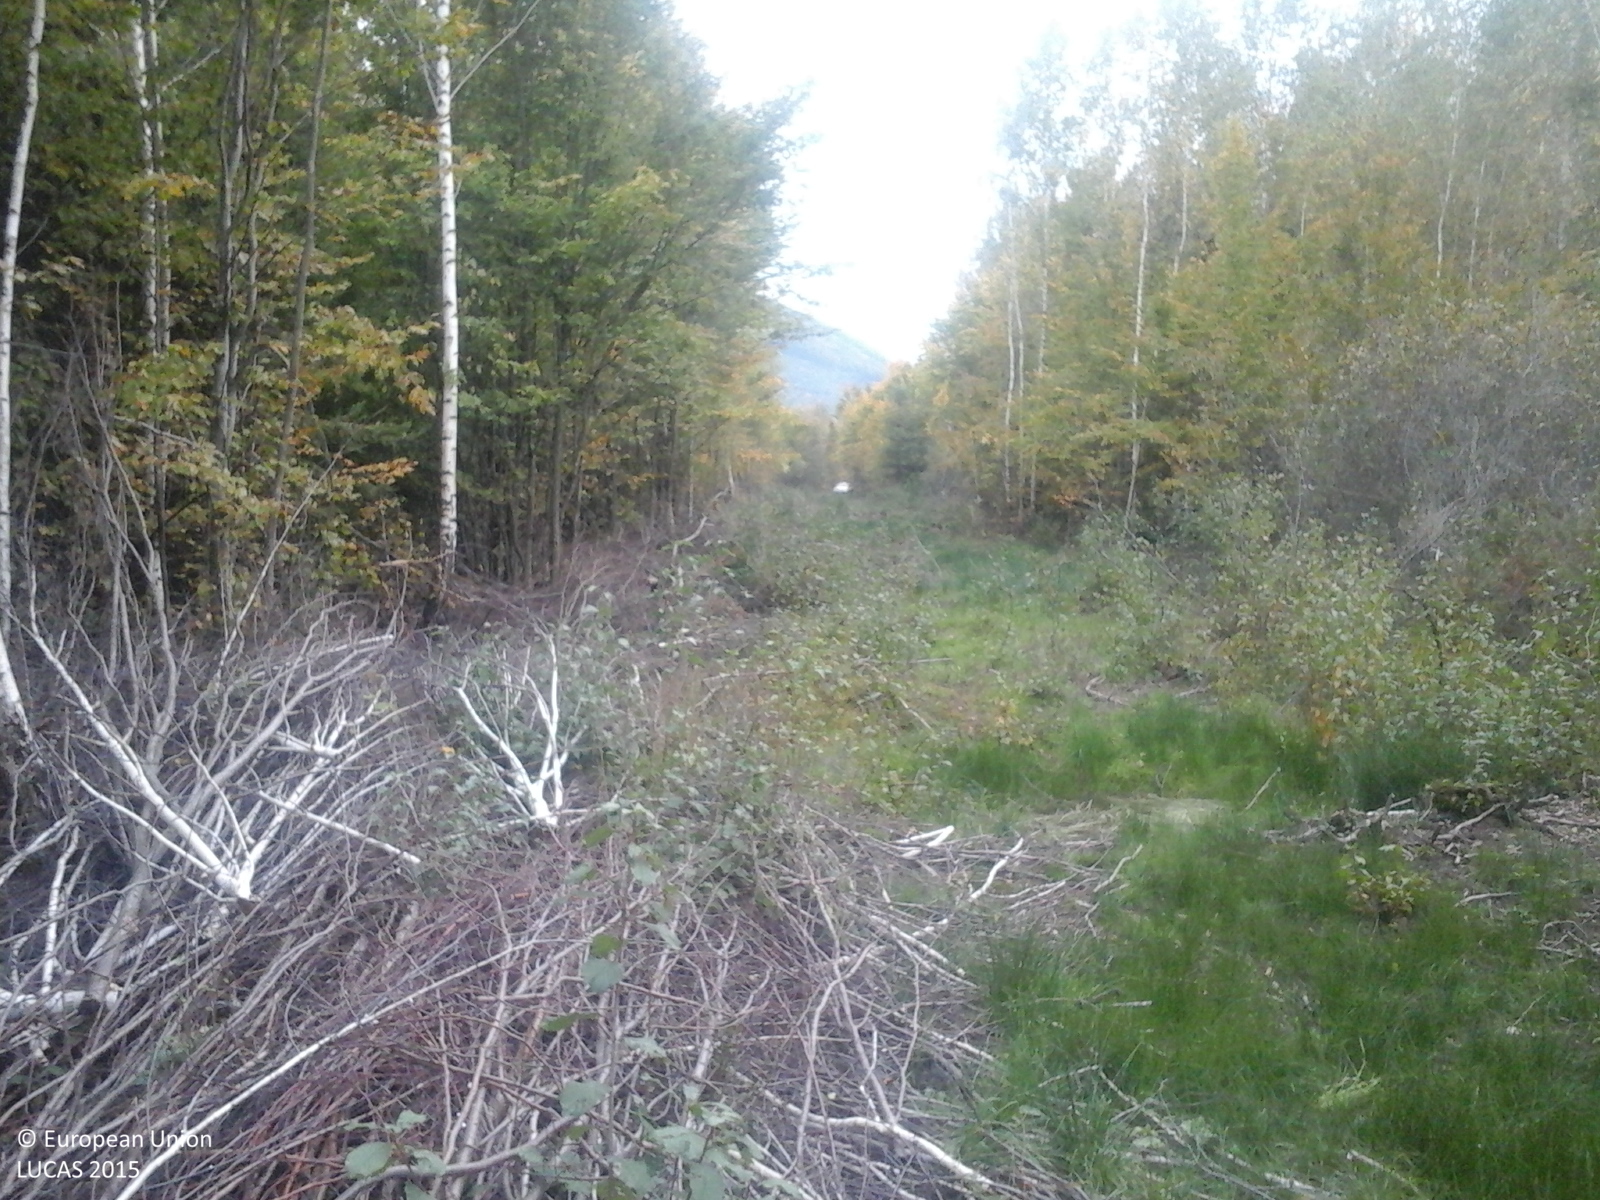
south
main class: Woodland
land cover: Broadleaved woodland
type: beech forest
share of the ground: > 75 %
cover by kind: broadleaved forest trees 100 %
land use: Forestry
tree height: > 5 m
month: October
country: RO
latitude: 45.7035
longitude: 24.7672
